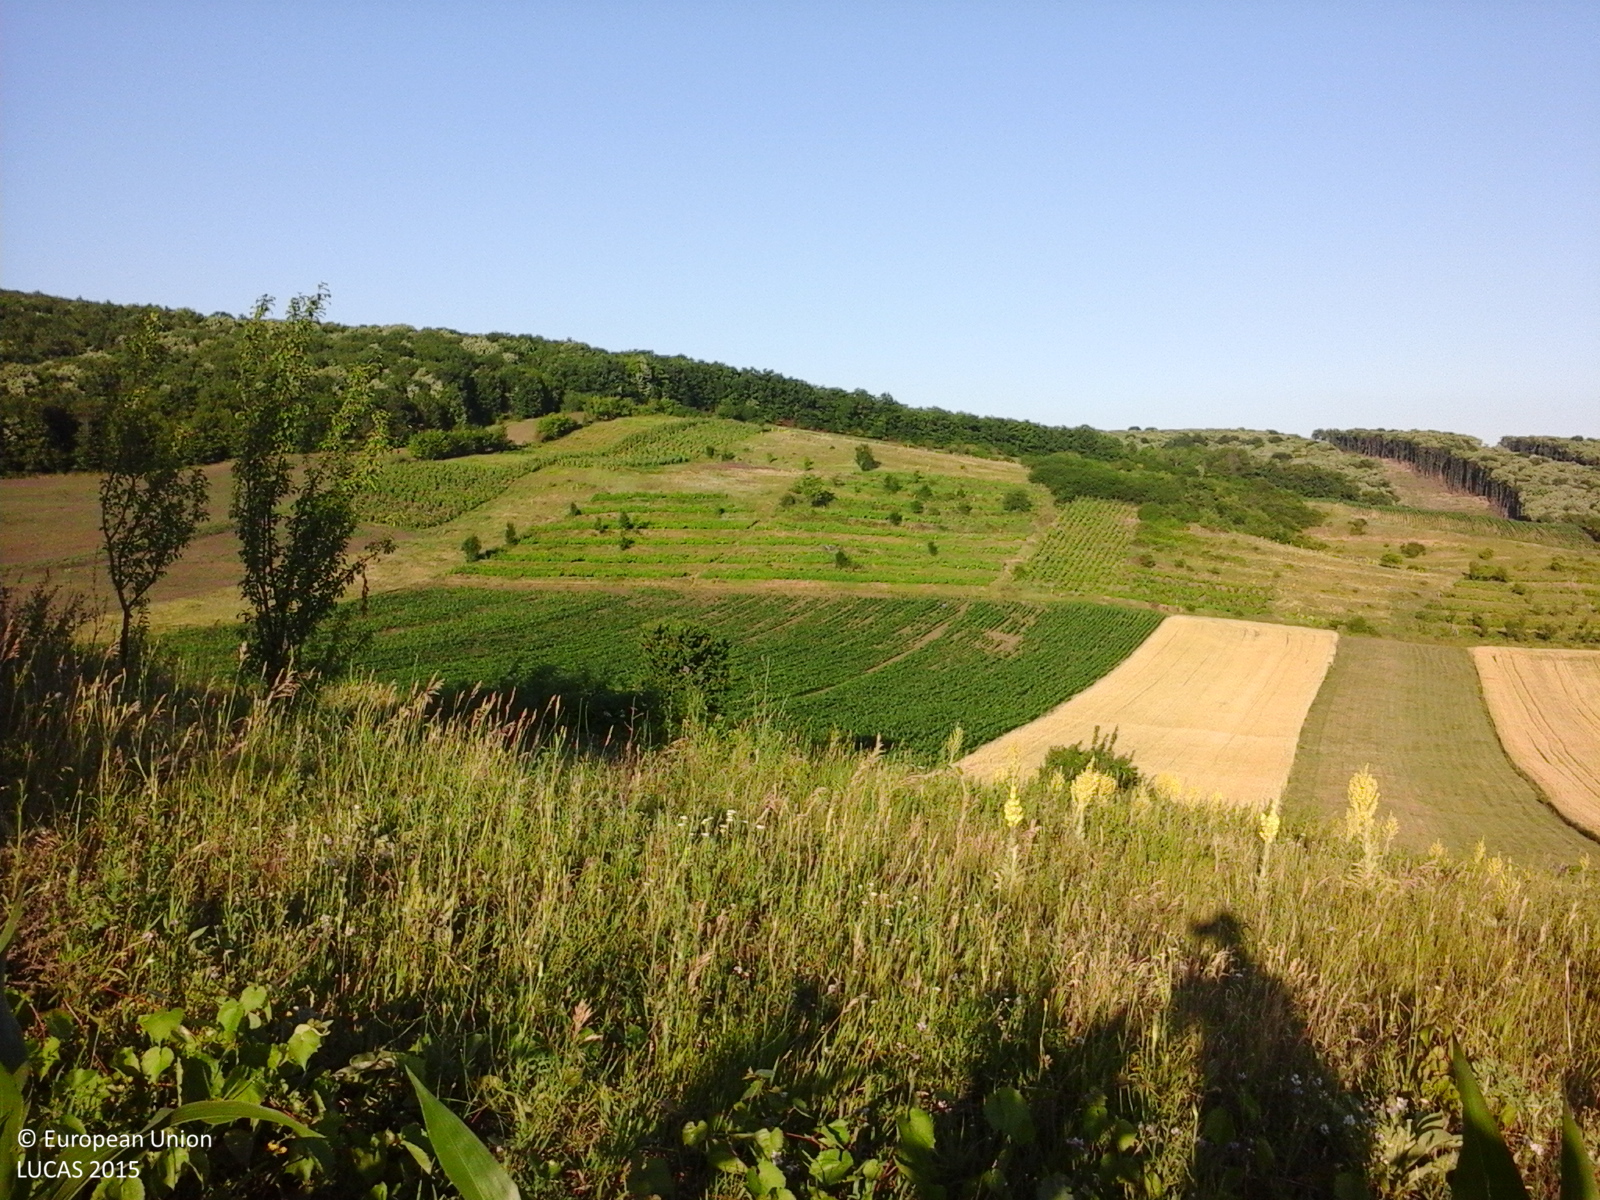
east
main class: Cropland
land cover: Maize
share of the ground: > 75 %
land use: Agriculture (excluding fallow land and kitchen gardens)
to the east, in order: Maize; Grassland without tree/shrub cover; Tracks; Grass margins; Lucerne; Single bushes/trees; Lucerne; Grass margins; Tracks; Grass margins; Maize
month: June
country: RO
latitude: 46.9394
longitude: 27.6017
